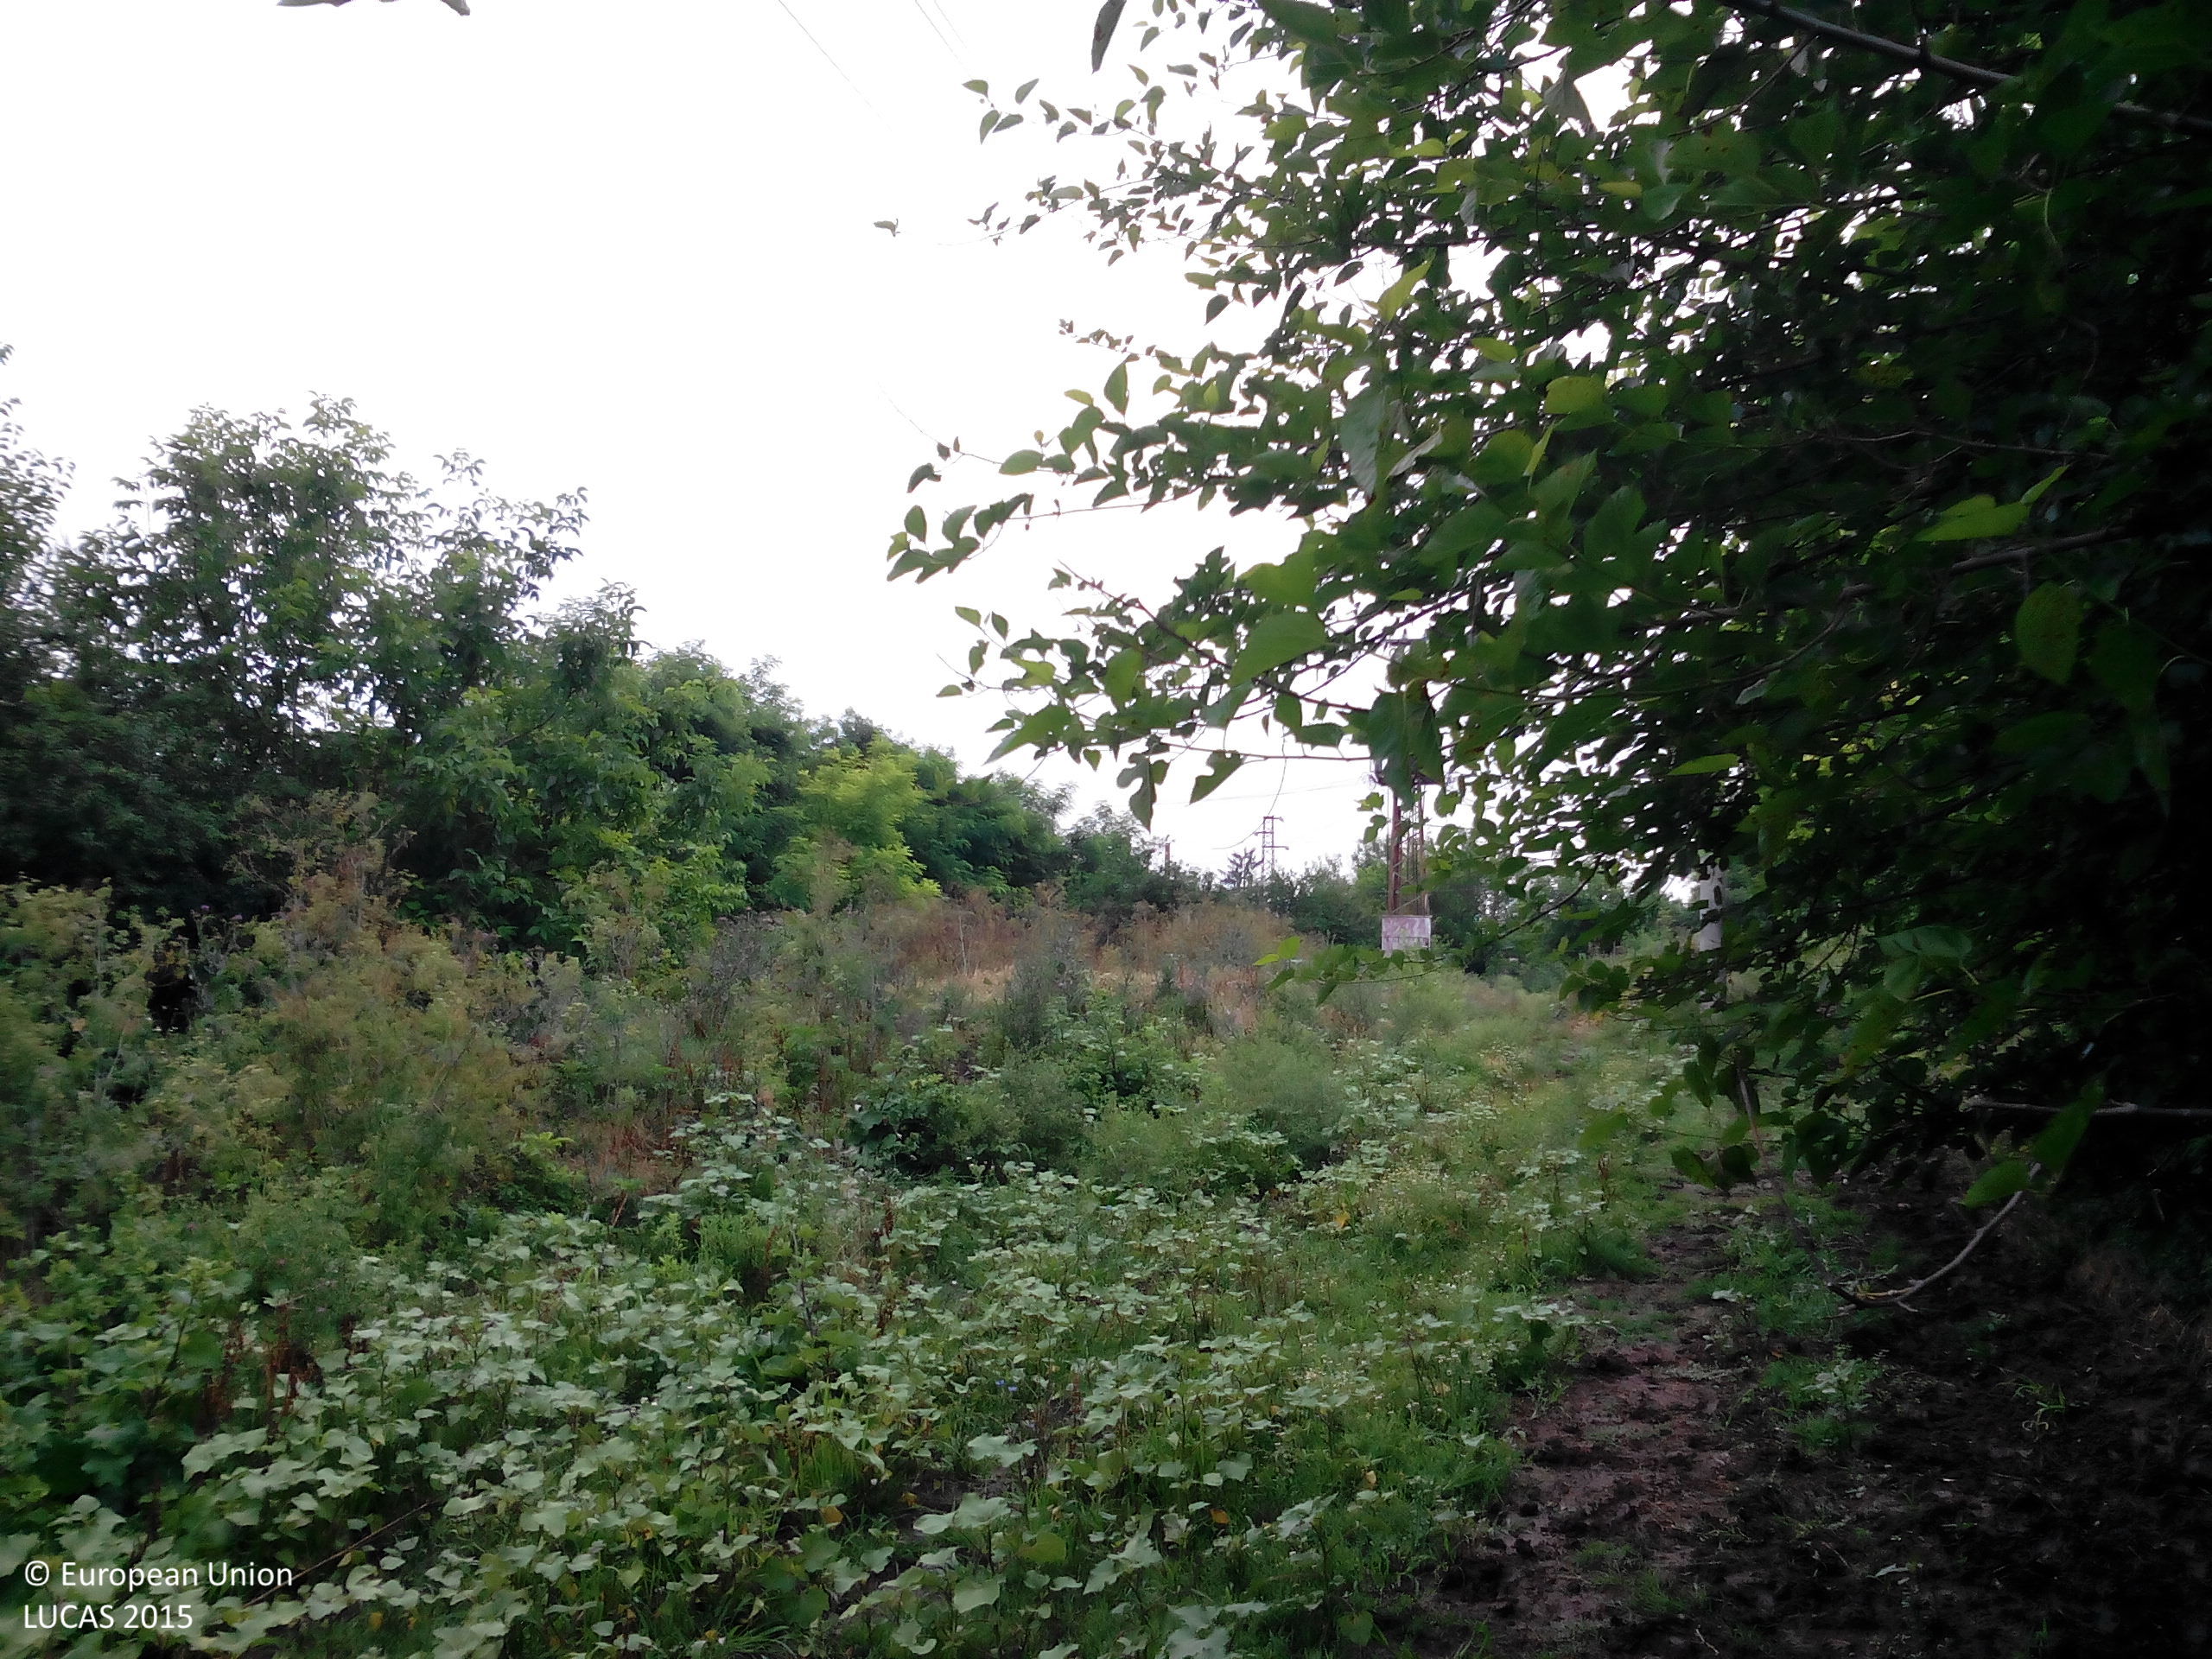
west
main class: Cropland
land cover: Maize
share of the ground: > 75 %
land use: Kitchen garden
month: July
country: BG
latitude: 43.4335
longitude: 24.1254
